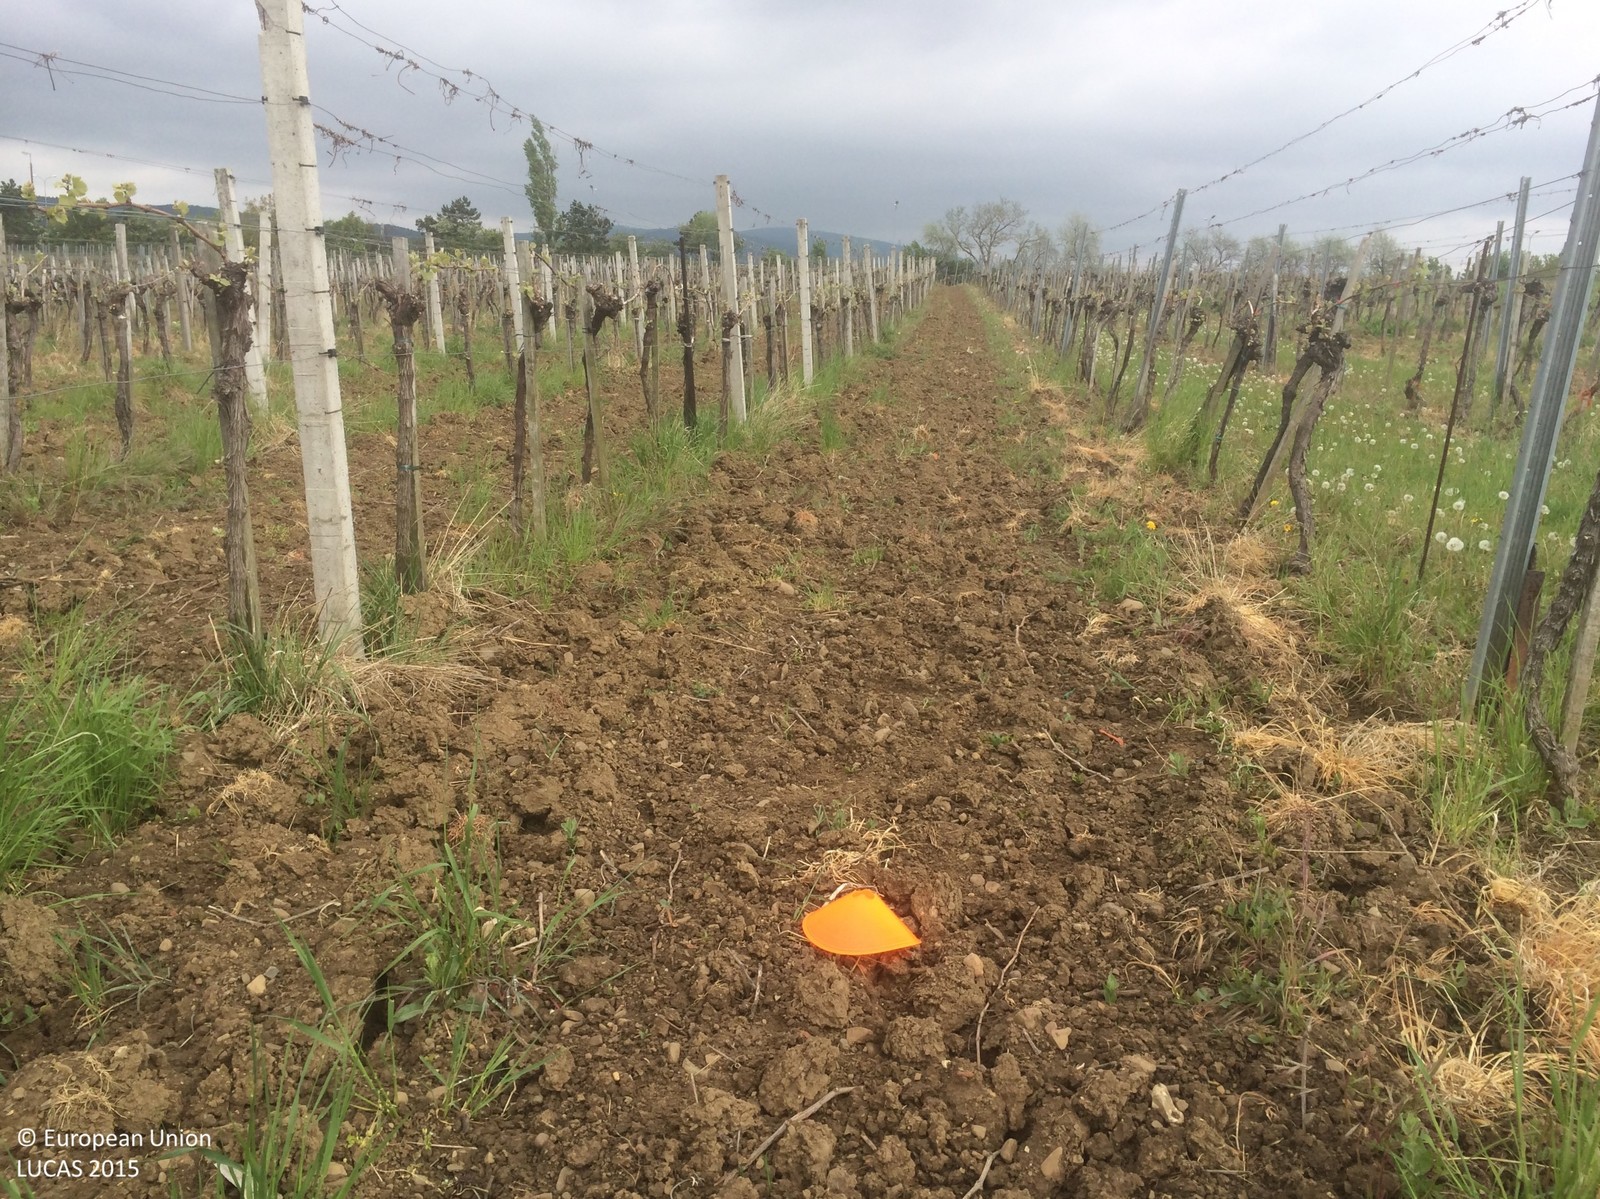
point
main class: Cropland
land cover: Vineyards
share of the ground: 25 - 50 %
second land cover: Spontaneously vegetated surfaces
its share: 50 - 75 %
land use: Agriculture (excluding fallow land and kitchen gardens)
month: May
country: AT
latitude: 47.9929
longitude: 16.2354
